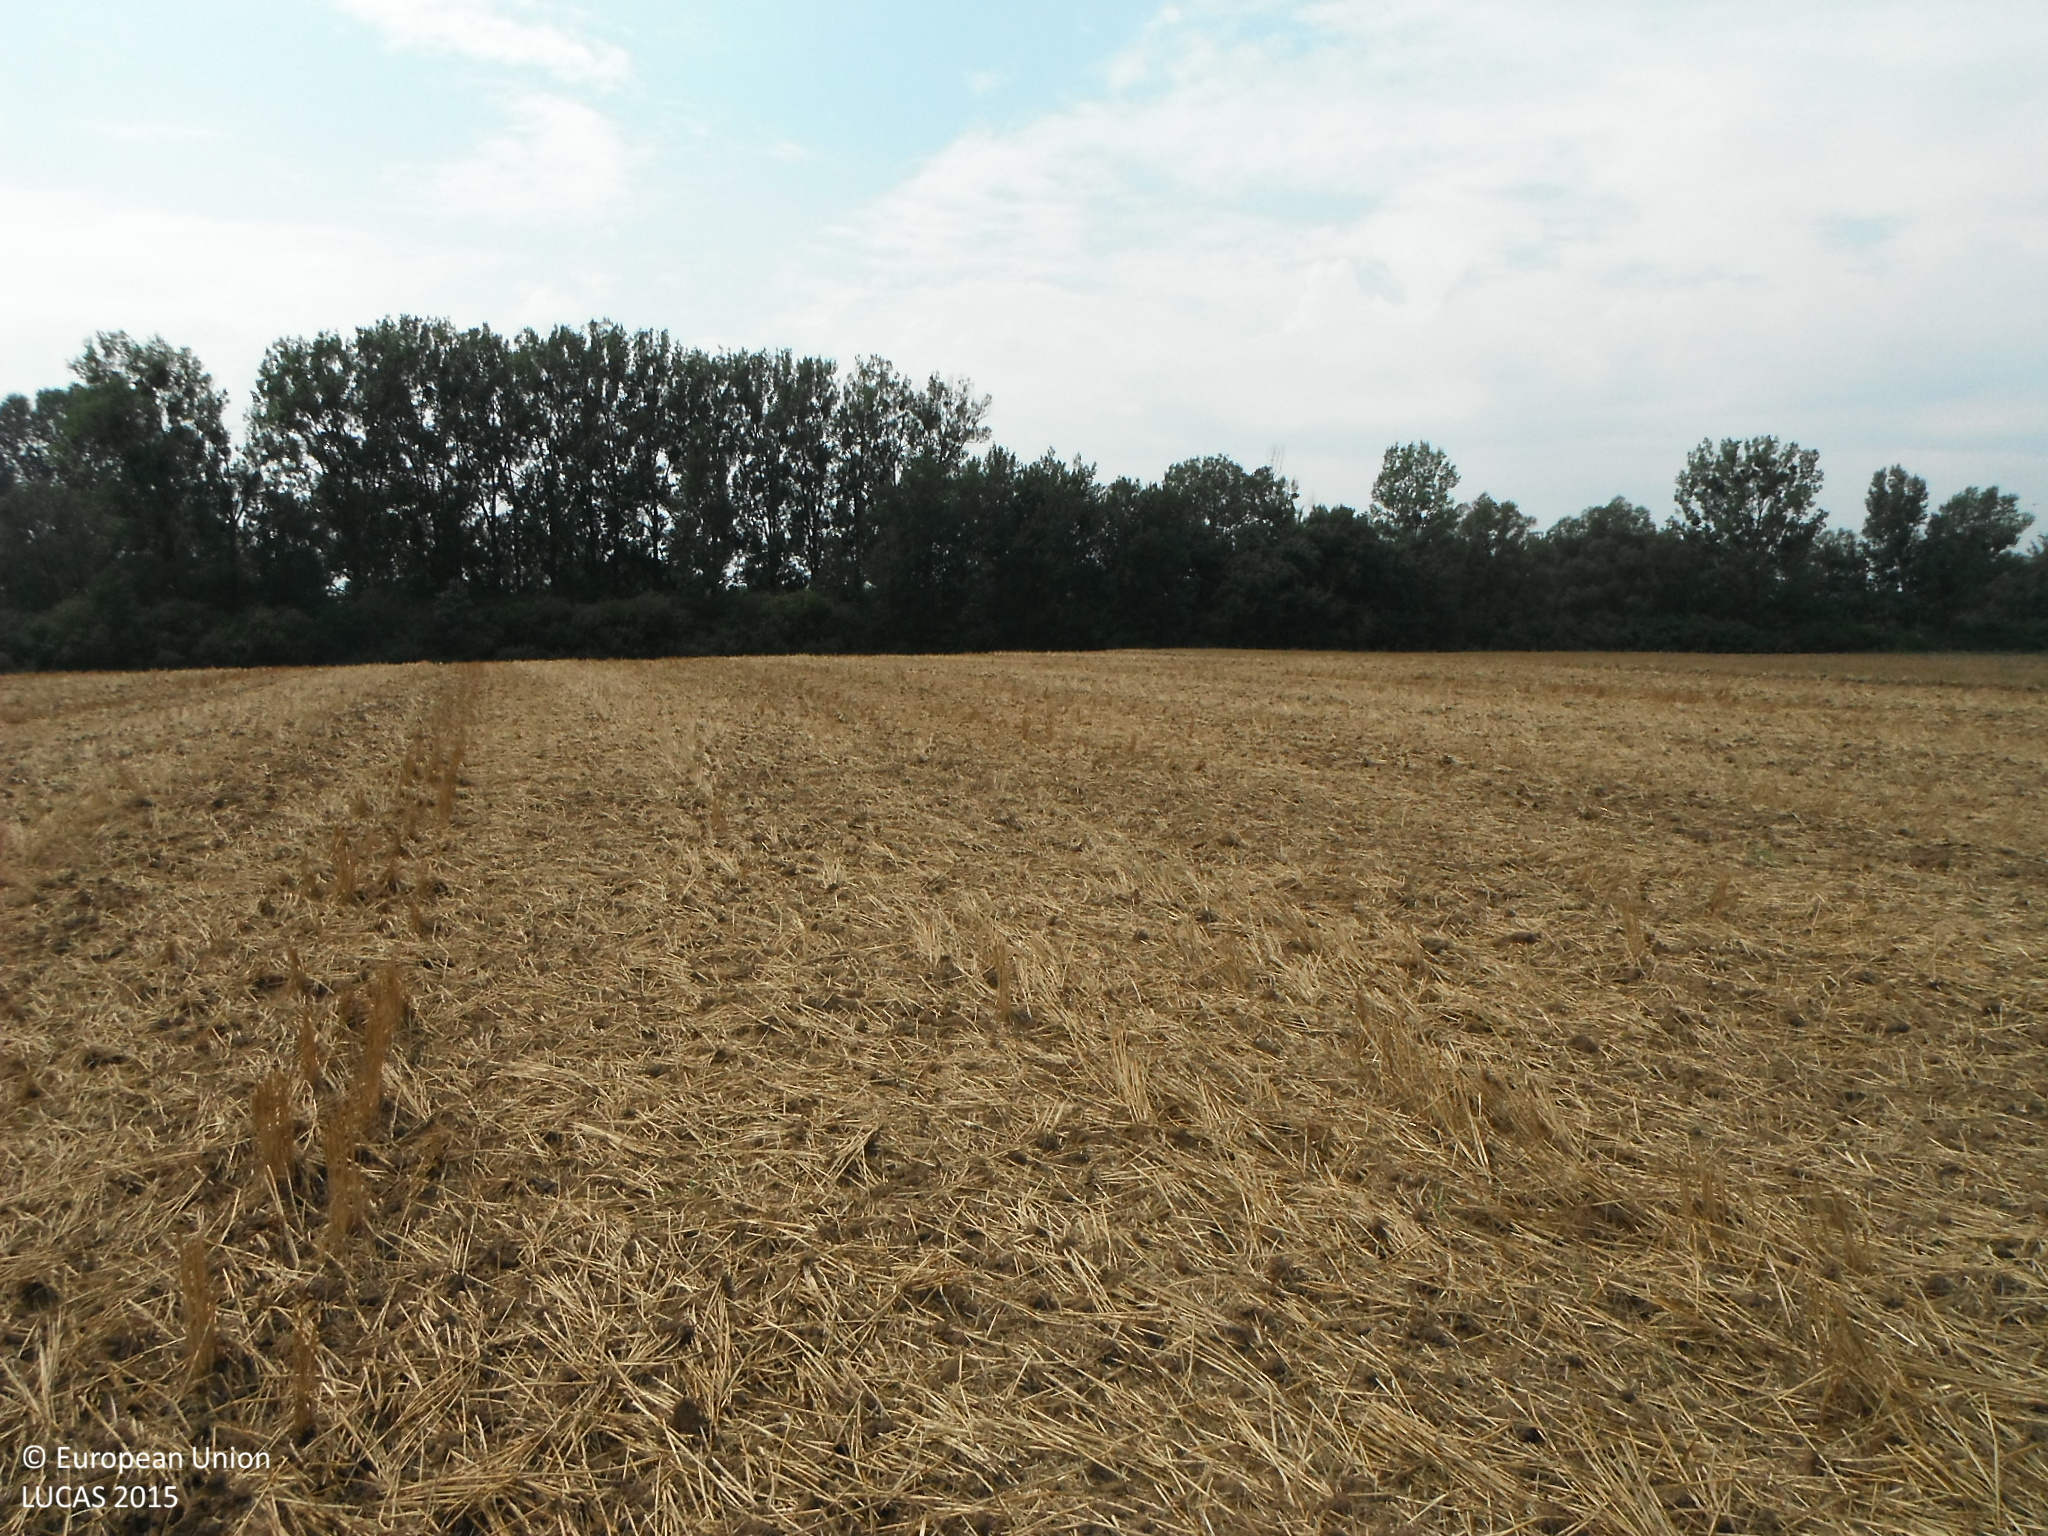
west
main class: Cropland
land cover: Common wheat
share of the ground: > 75 %
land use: Agriculture (excluding fallow land and kitchen gardens)
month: August
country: SK
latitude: 48.4631
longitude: 21.9405
